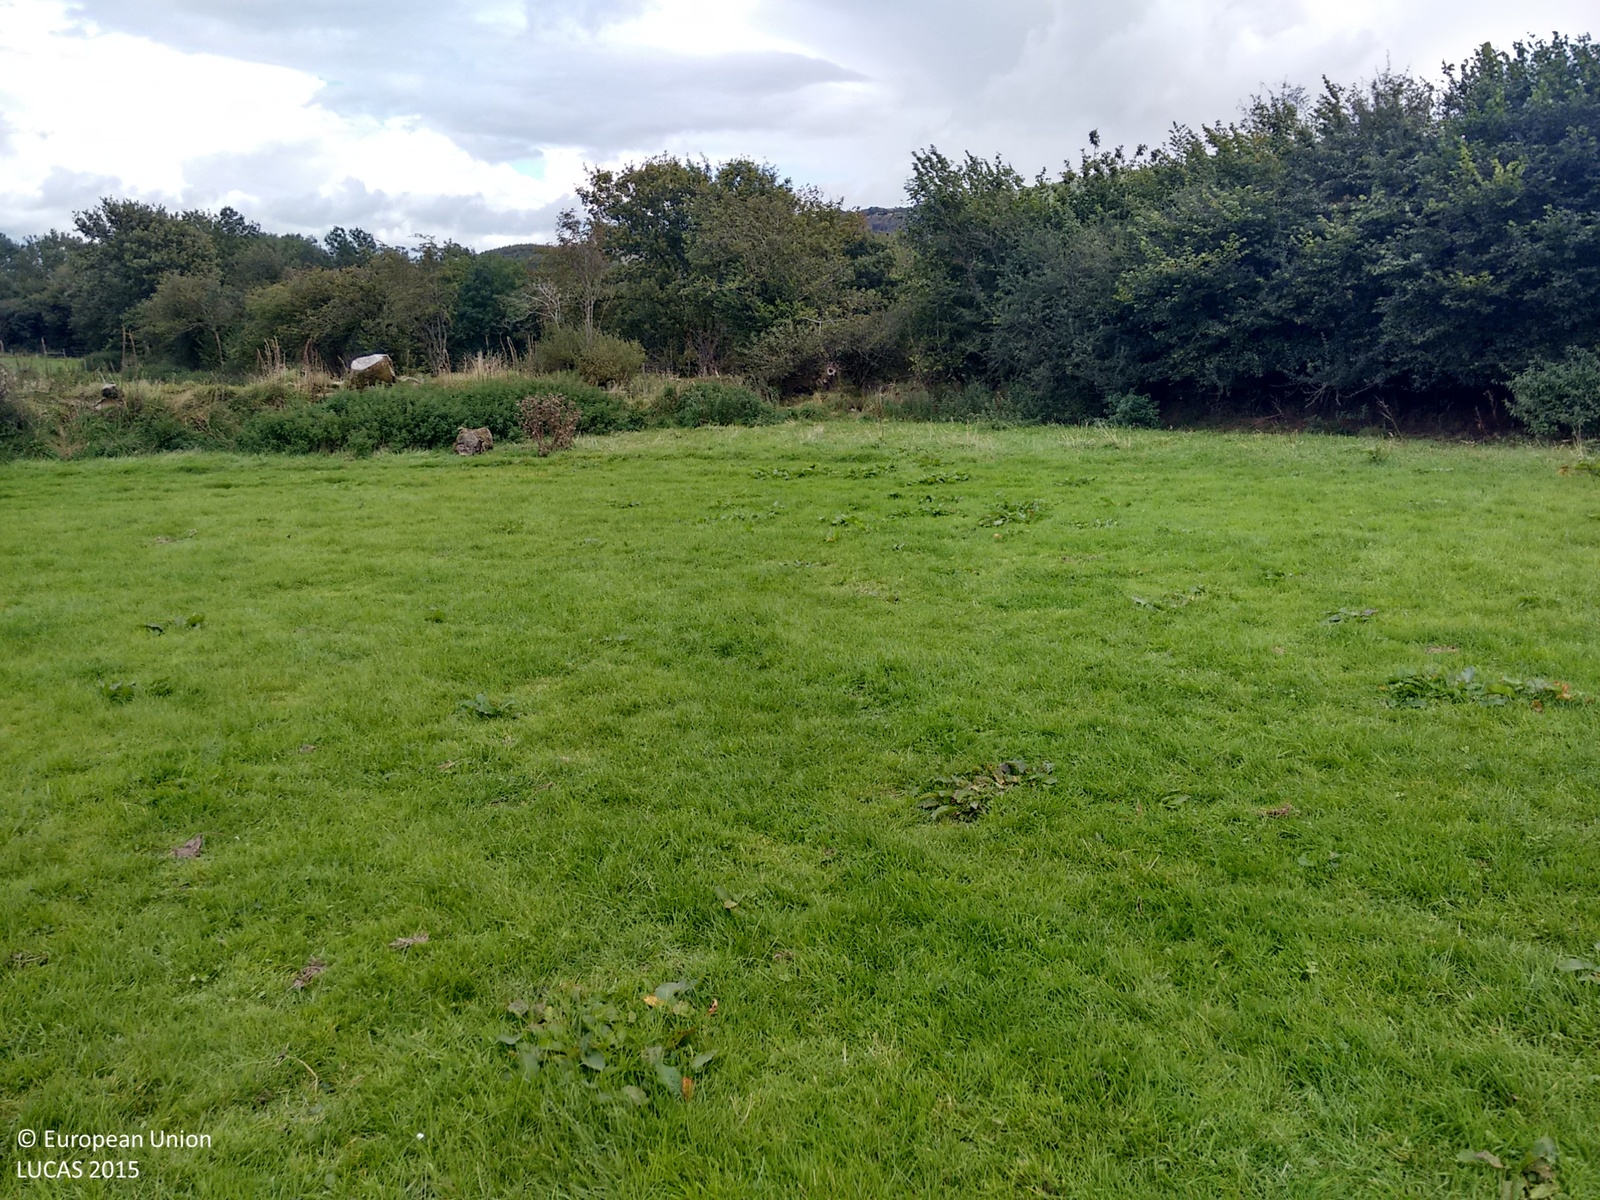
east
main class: Grassland
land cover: Grassland without tree/shrub cover
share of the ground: > 75 %
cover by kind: herbaceous plants 100 %
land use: Agriculture (excluding fallow land and kitchen gardens)
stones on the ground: < 10 %
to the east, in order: Grassland without tree/shrub cover; Broadleaved woodland; Grassland without tree/shrub cover; Broadleaved woodland; Fences; Grassland without tree/shrub cover; Fences; Broadleaved woodland; Grass margins; Paved roads, cycling and walking lanes; Grass margins; Broadleaved woodland; Fences; Other bare soil; Fences; Broadleaved woodland; Fences; Grassland without tree/shrub cover
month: September
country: GB
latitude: 50.7151
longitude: -4.0454
